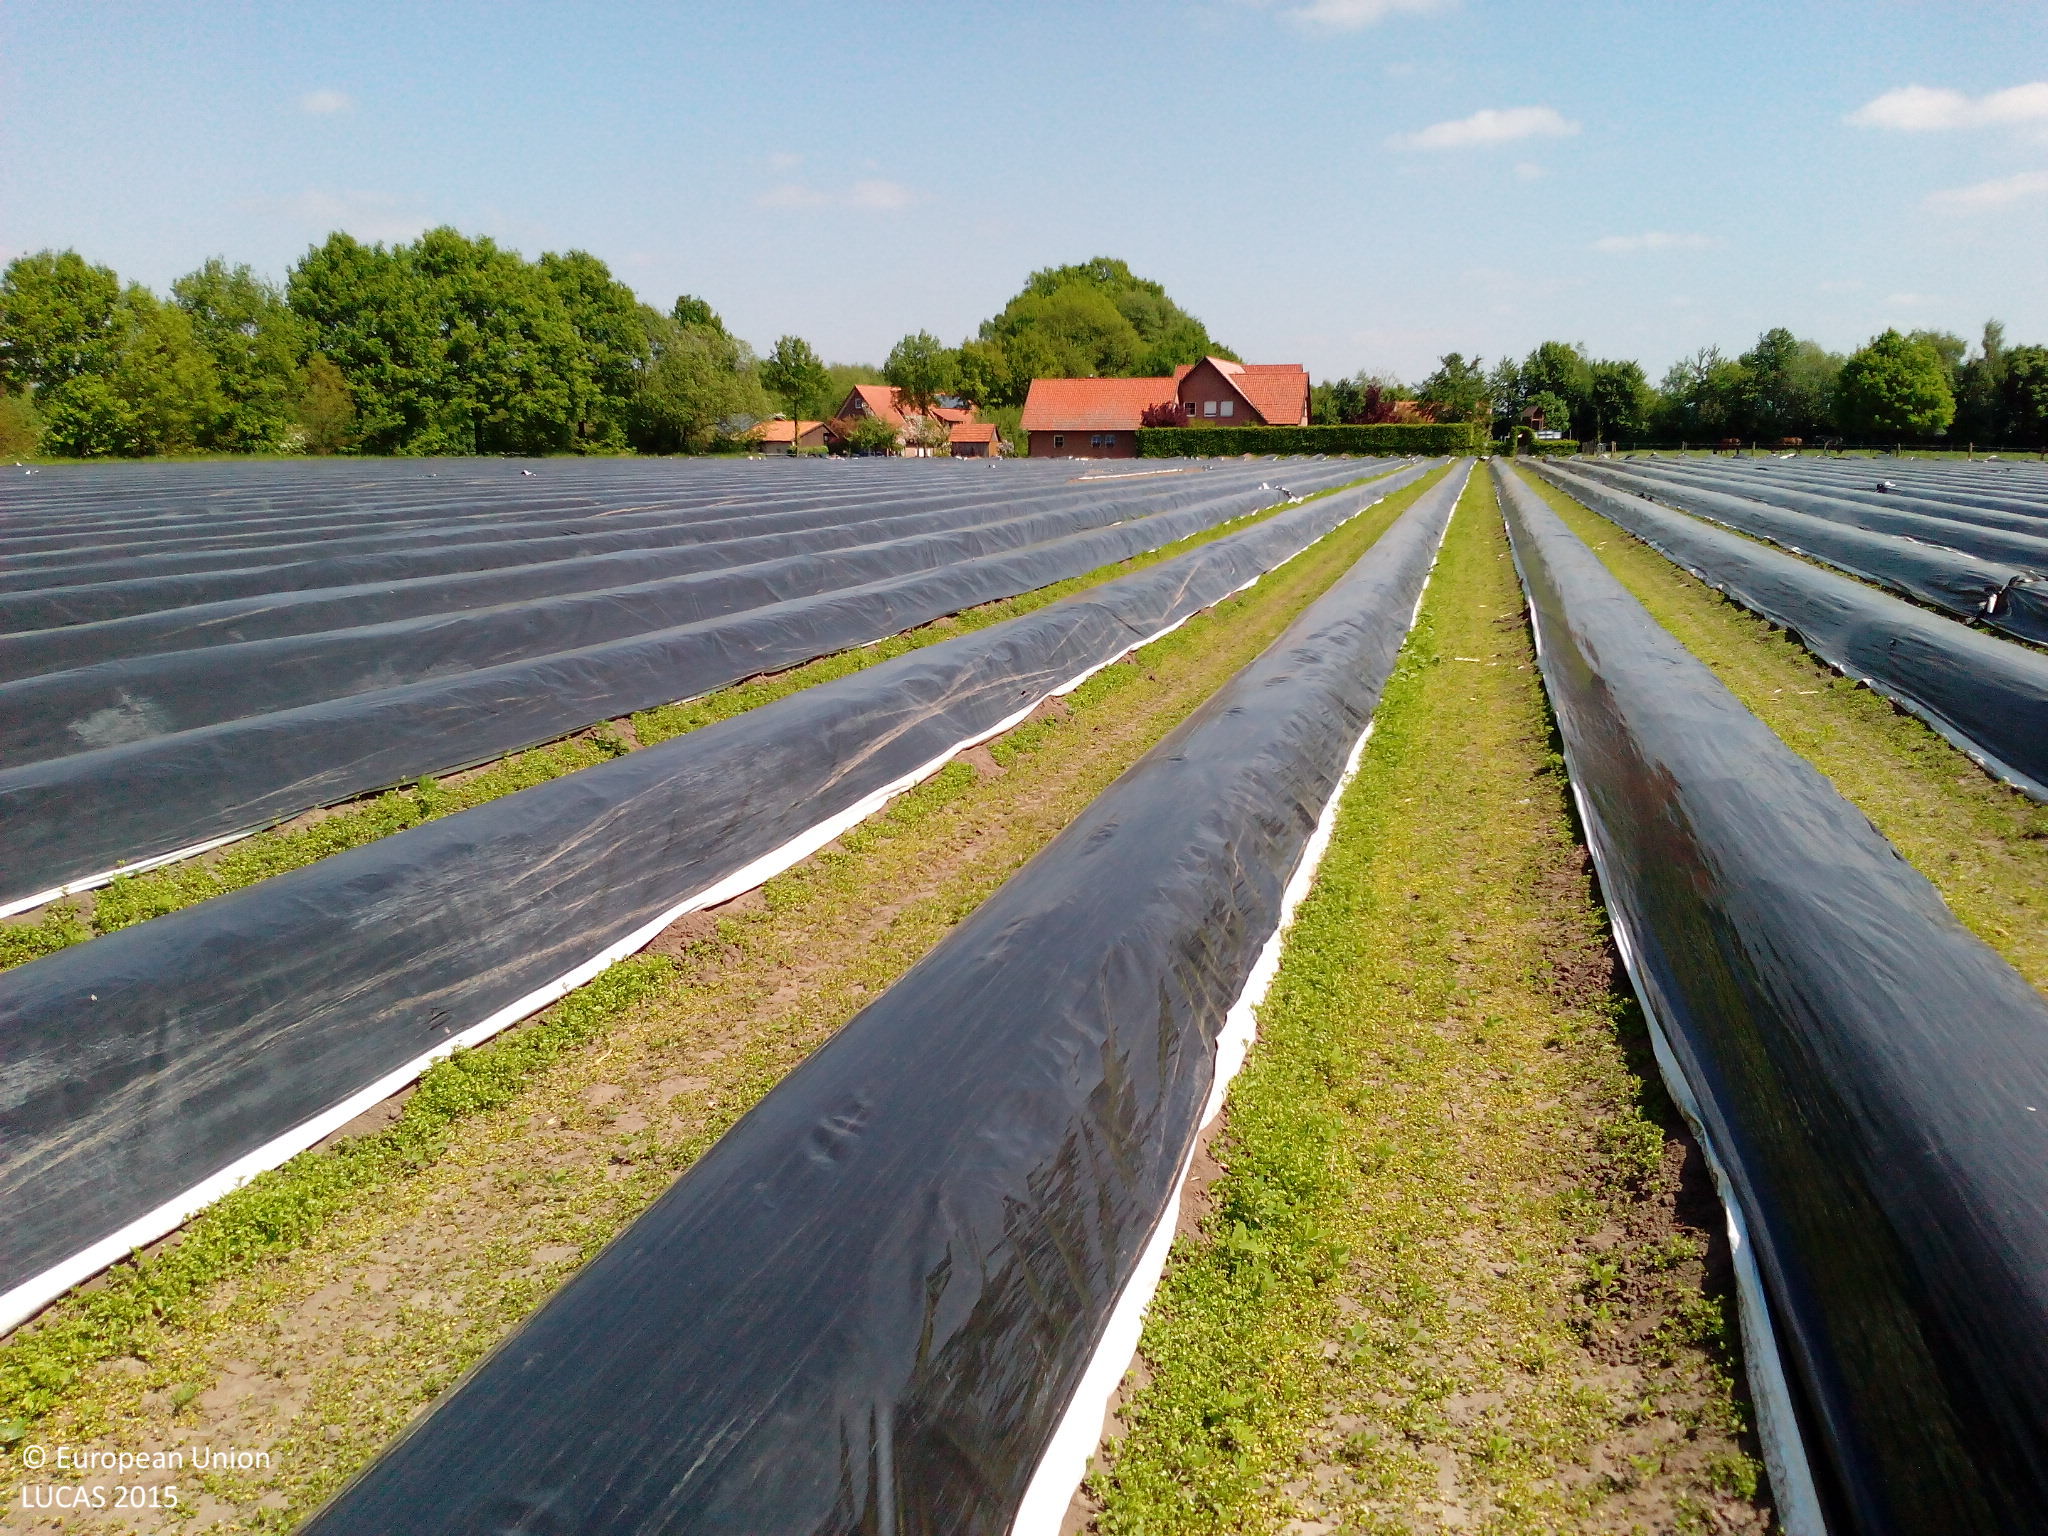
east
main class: Cropland
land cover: Other fresh vegetables
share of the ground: < 10 %
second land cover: Spontaneously vegetated surfaces
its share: 50 - 75 %
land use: Agriculture (excluding fallow land and kitchen gardens)
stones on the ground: < 10 %
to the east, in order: Other fresh vegetables; Spontaneously vegetated surfaces; Grass margins; Artificial constructions in urban areas; Broadleaved woodland; Paved roads, cycling and walking lanes; Broadleaved woodland
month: May
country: DE
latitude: 51.9477
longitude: 8.0363
